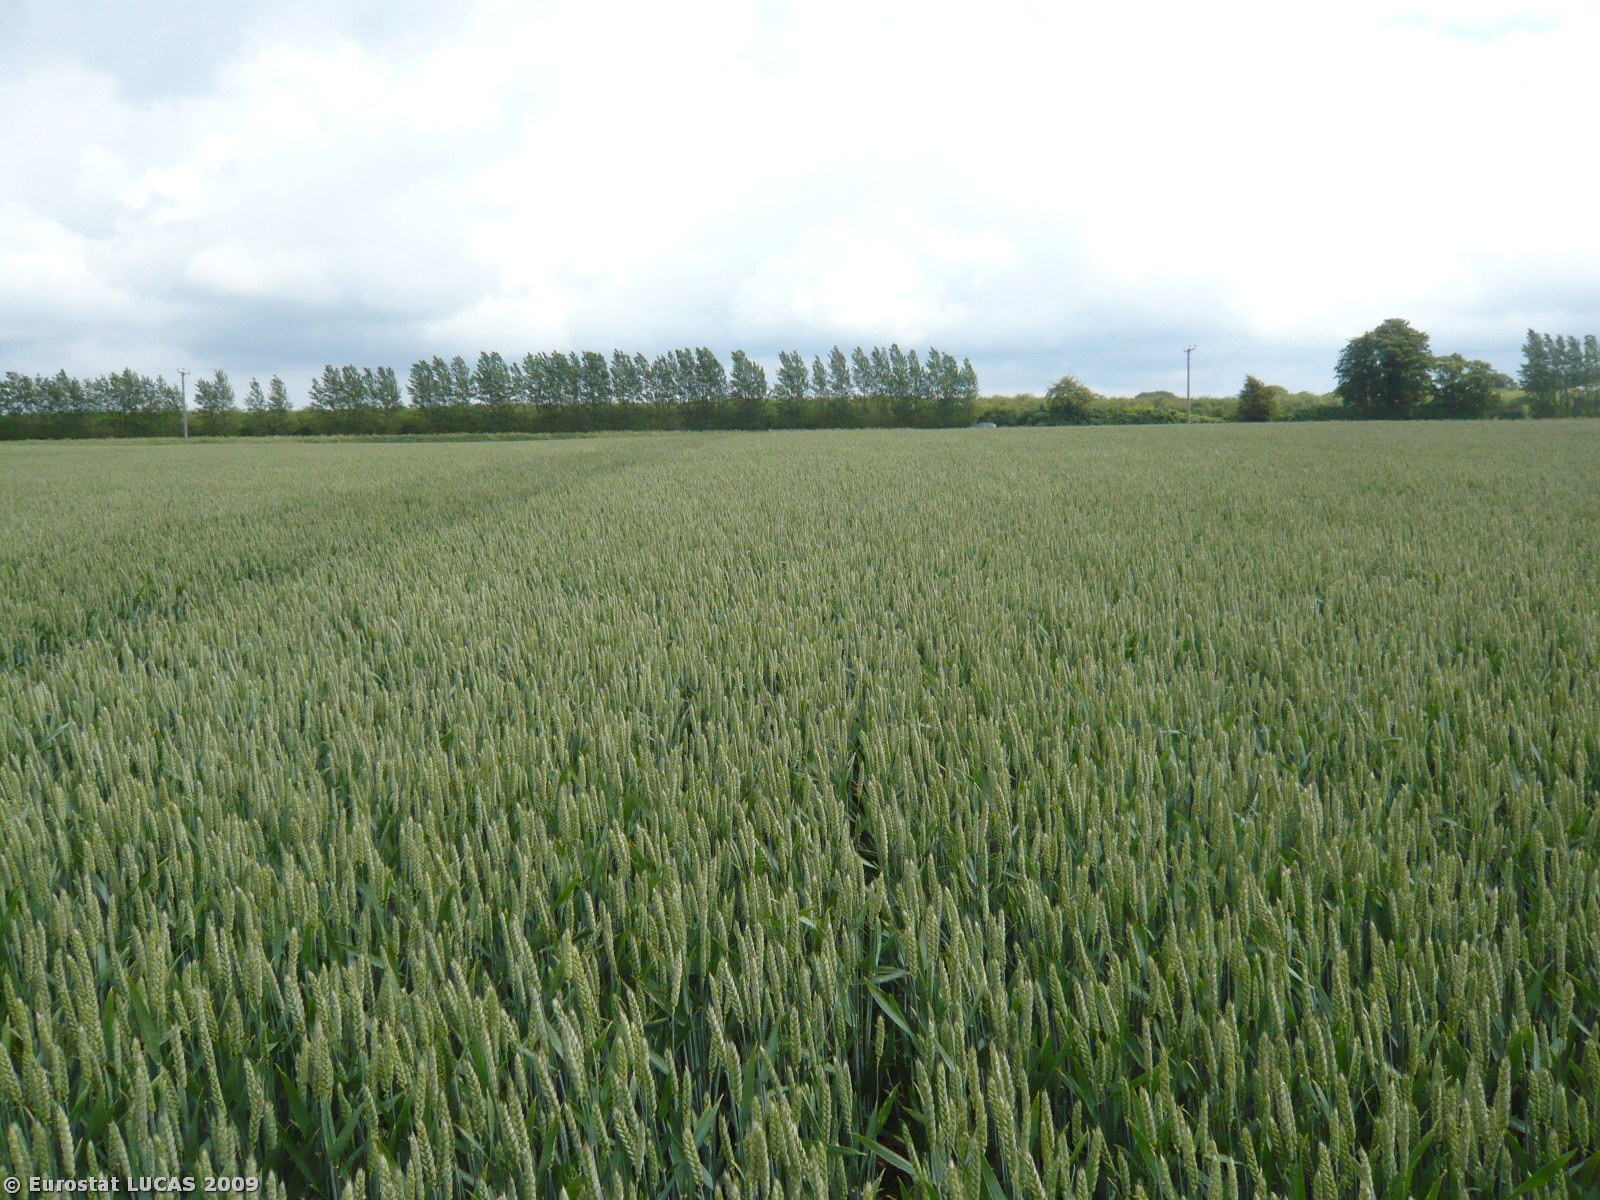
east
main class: Cropland
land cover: Common wheat
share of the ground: > 75 %
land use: Agriculture (excluding fallow land and kitchen gardens)
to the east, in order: Common wheat; Electric lines; Common wheat; Grassland without tree/shrub cover; Paved roads, cycling and walking lanes; Grass margins; Lines of trees; Fences; Cherry fruit
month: June
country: DK
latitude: 54.8983
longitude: 11.8232
